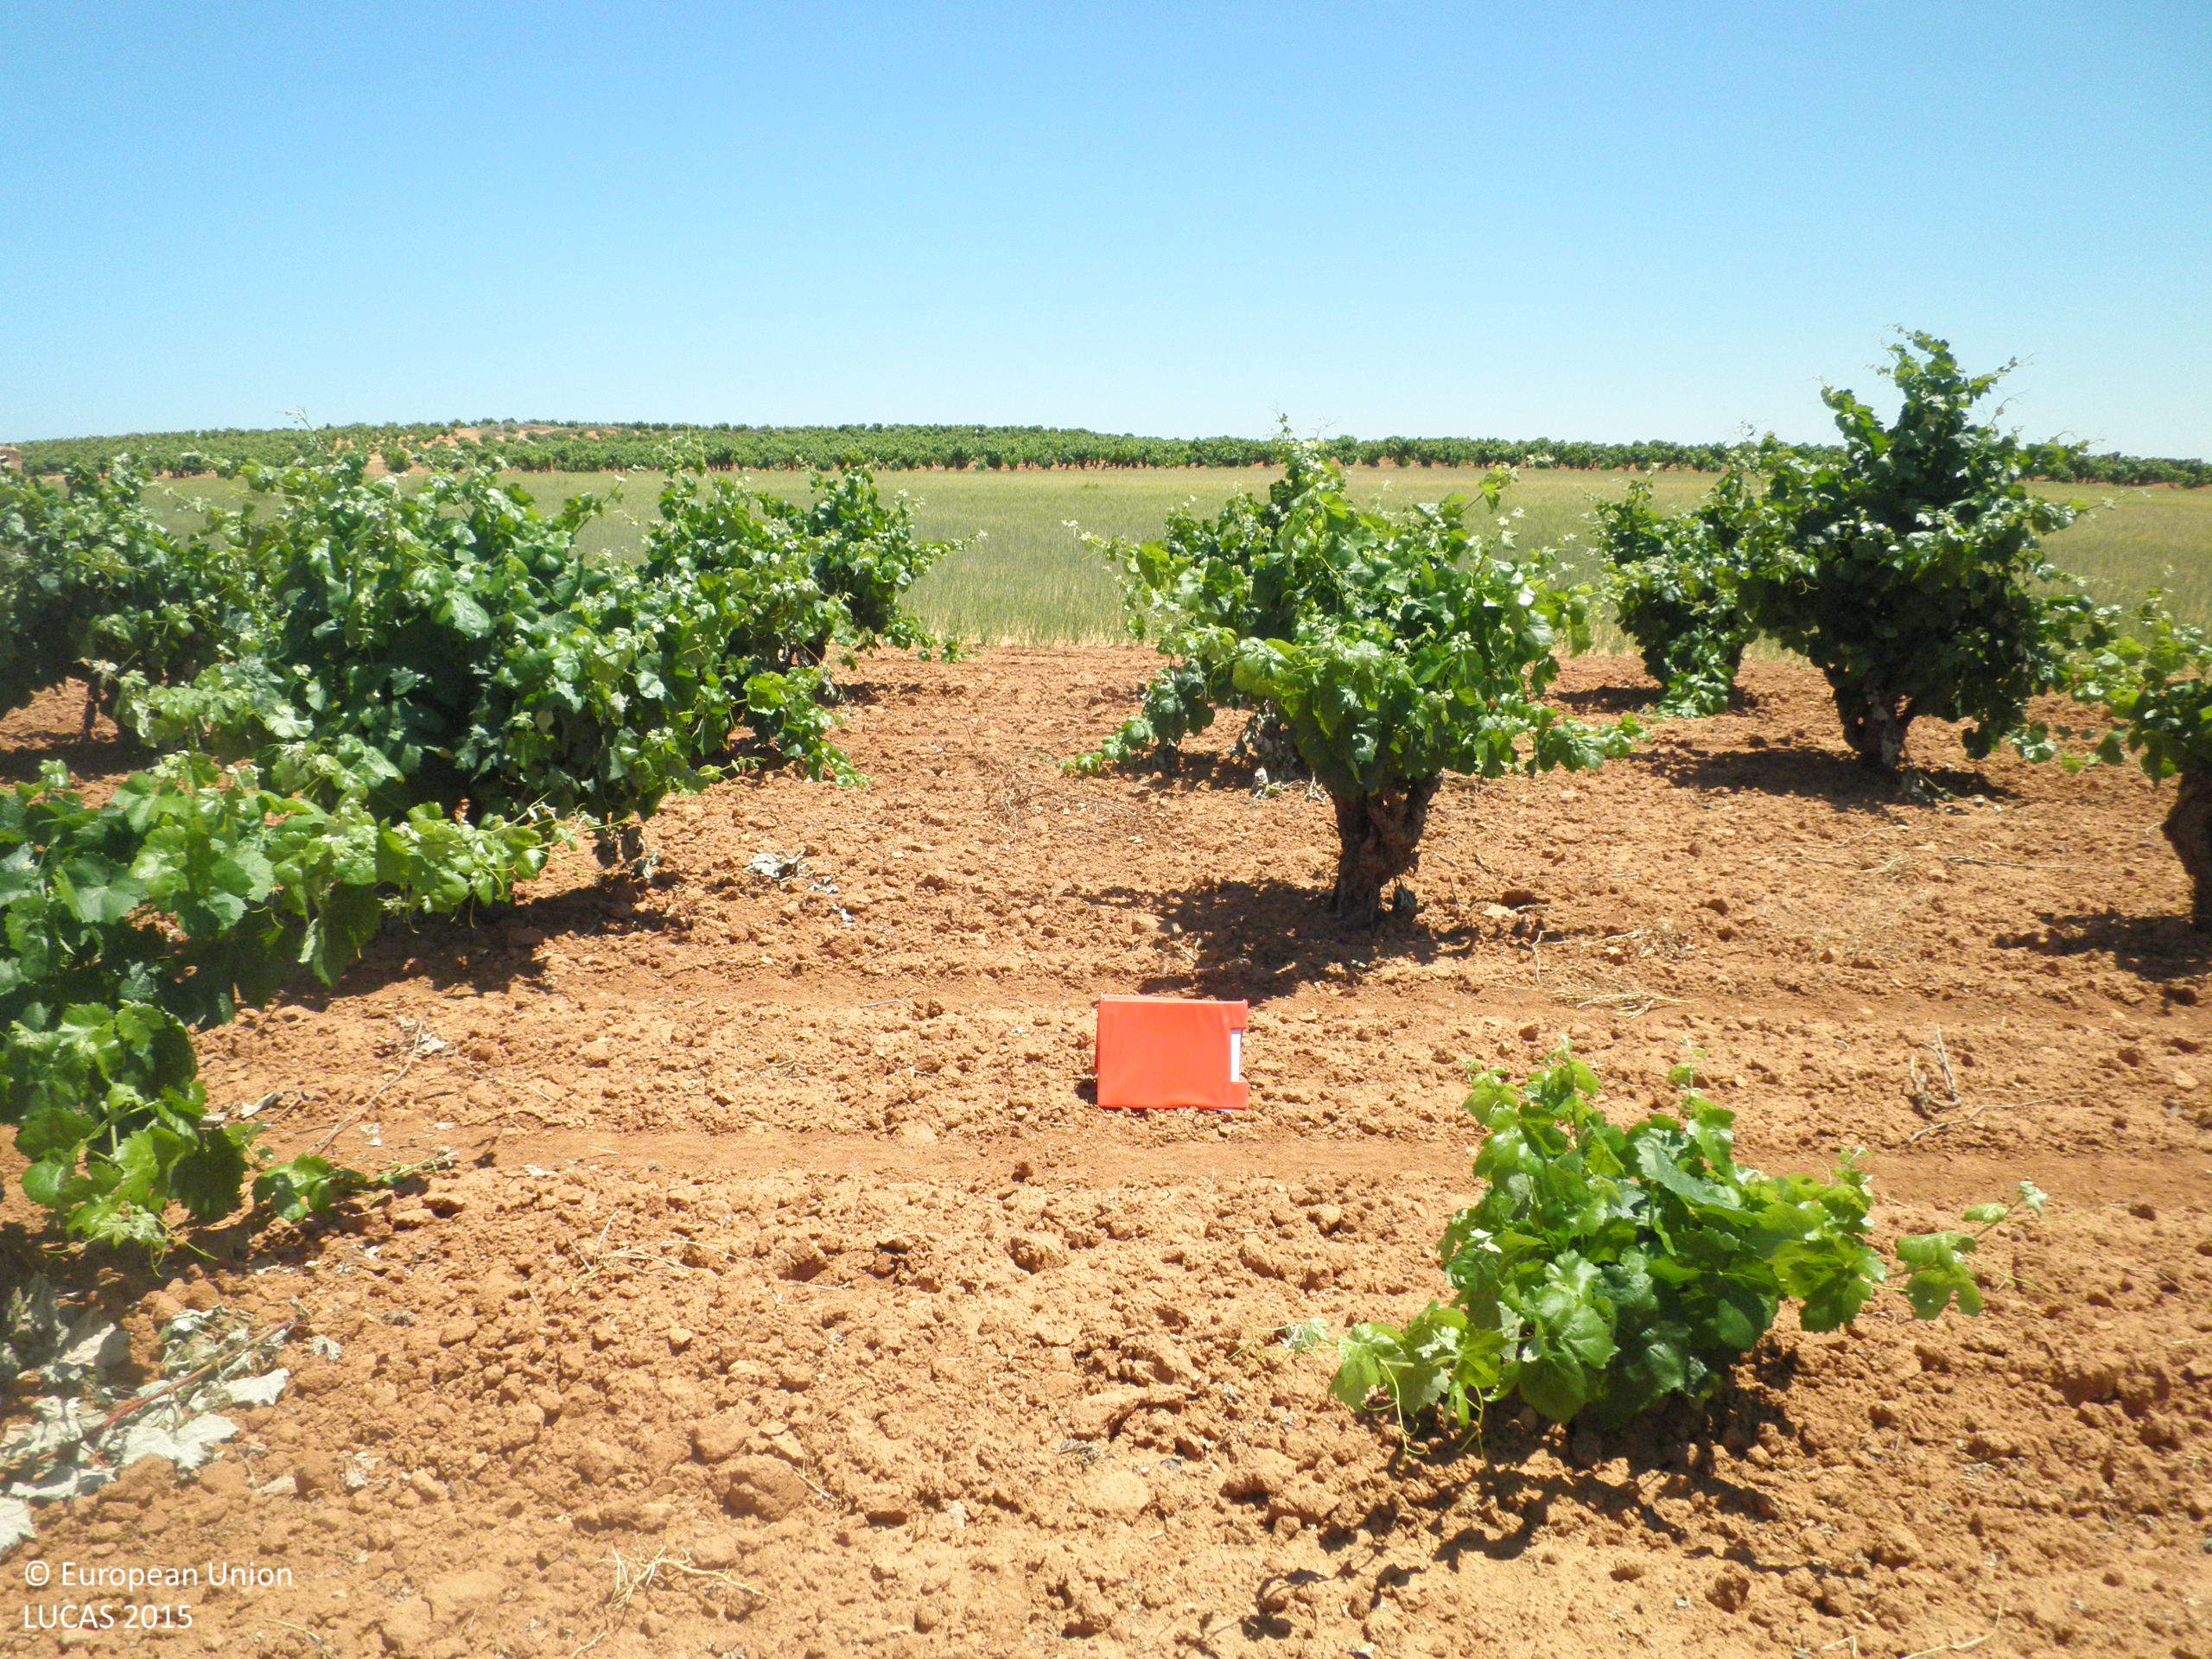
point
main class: Cropland
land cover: Vineyards
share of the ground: 10 - 25 %
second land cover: Other bare soil
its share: > 75 %
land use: Agriculture (excluding fallow land and kitchen gardens)
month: June
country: ES
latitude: 39.4749
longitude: -1.6879
